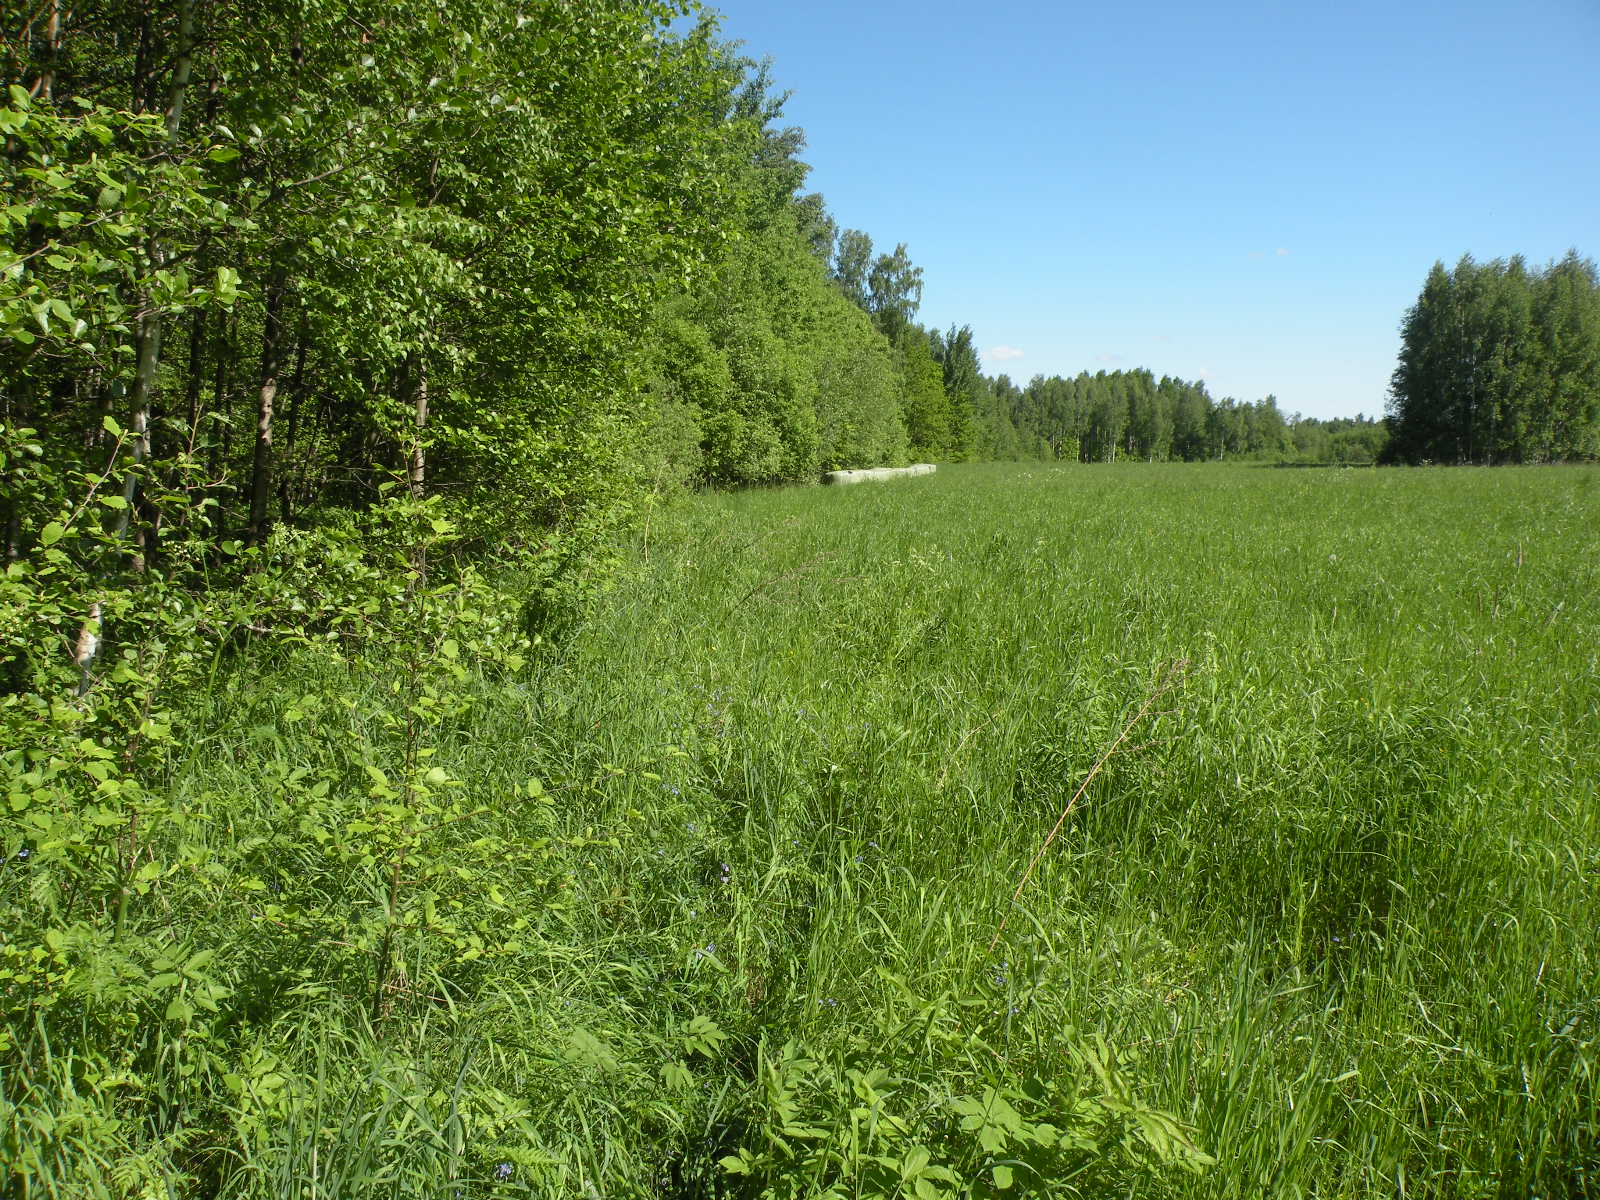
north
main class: Grassland
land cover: Grassland without tree/shrub cover
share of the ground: > 75 %
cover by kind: herbaceous plants 100 %
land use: Agriculture (excluding fallow land and kitchen gardens)
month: May
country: LV
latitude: 56.0259
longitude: 26.2360
